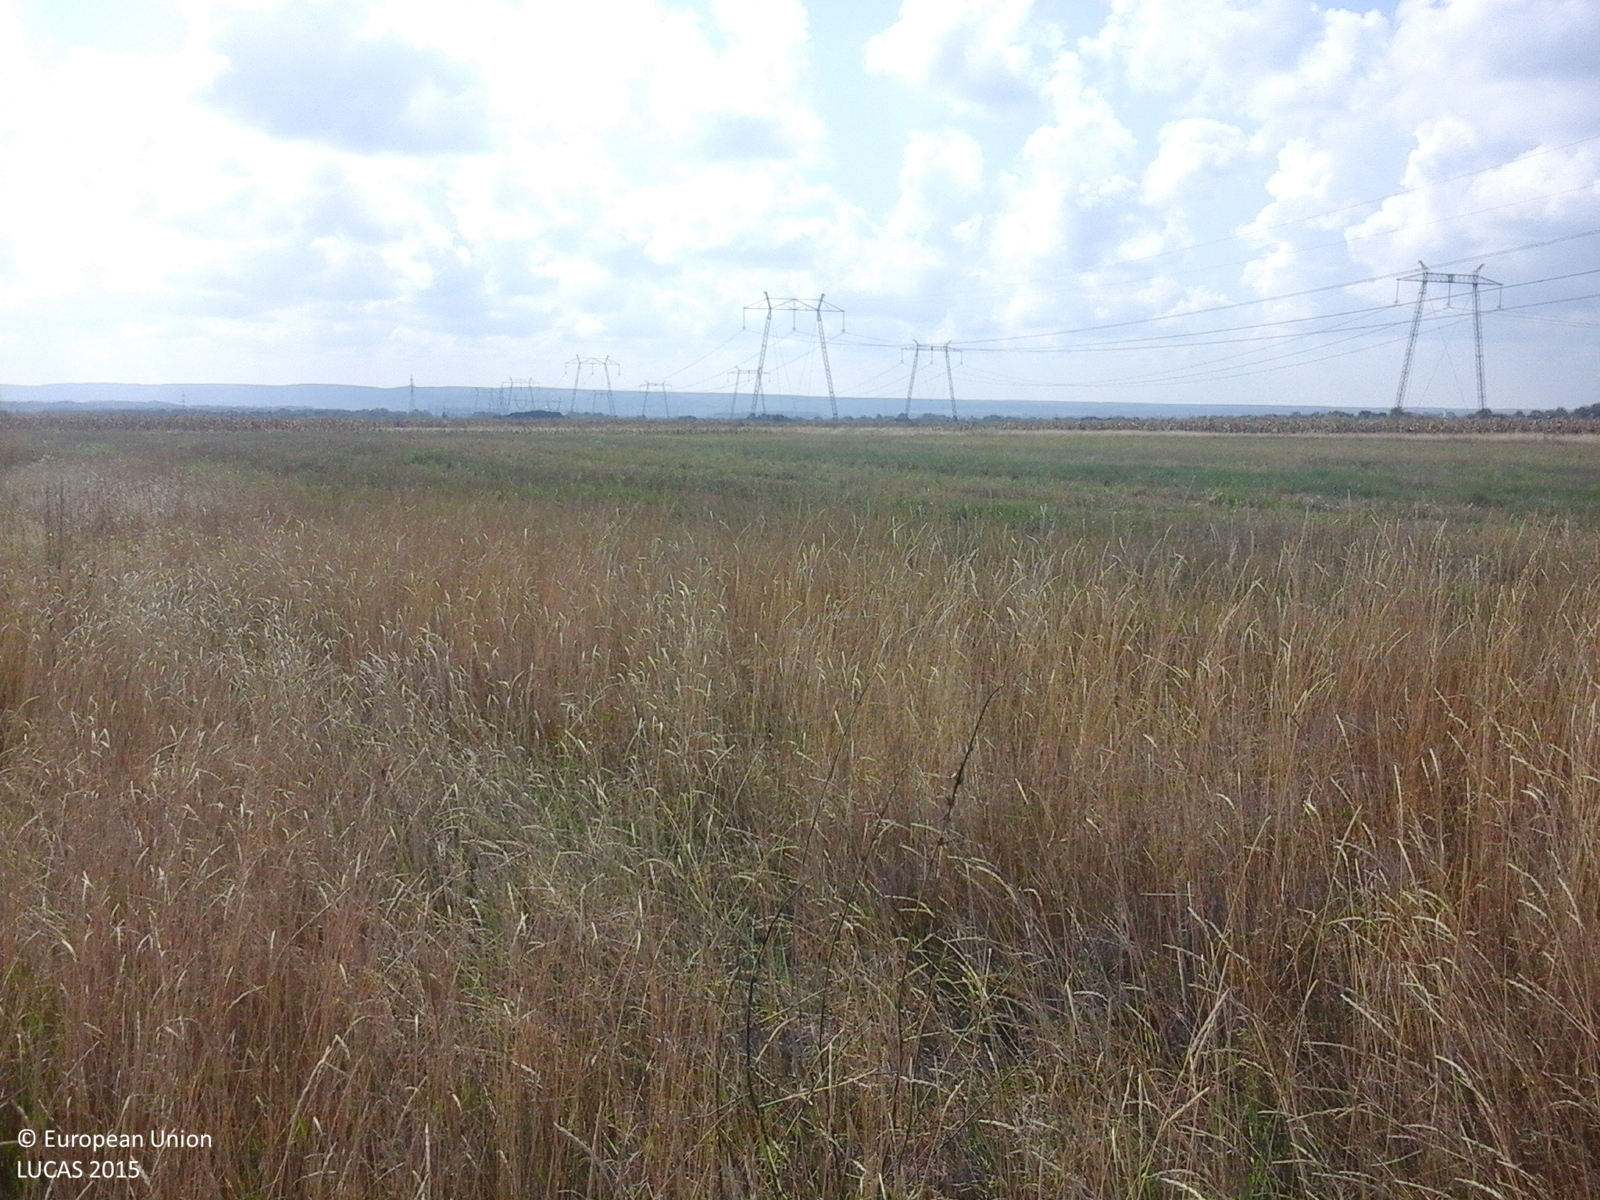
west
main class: Grassland
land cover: Spontaneously vegetated surfaces
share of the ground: > 75 %
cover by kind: herbaceous plants 100 %
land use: Fallow land
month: September
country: RO
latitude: 45.0278
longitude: 23.5499
